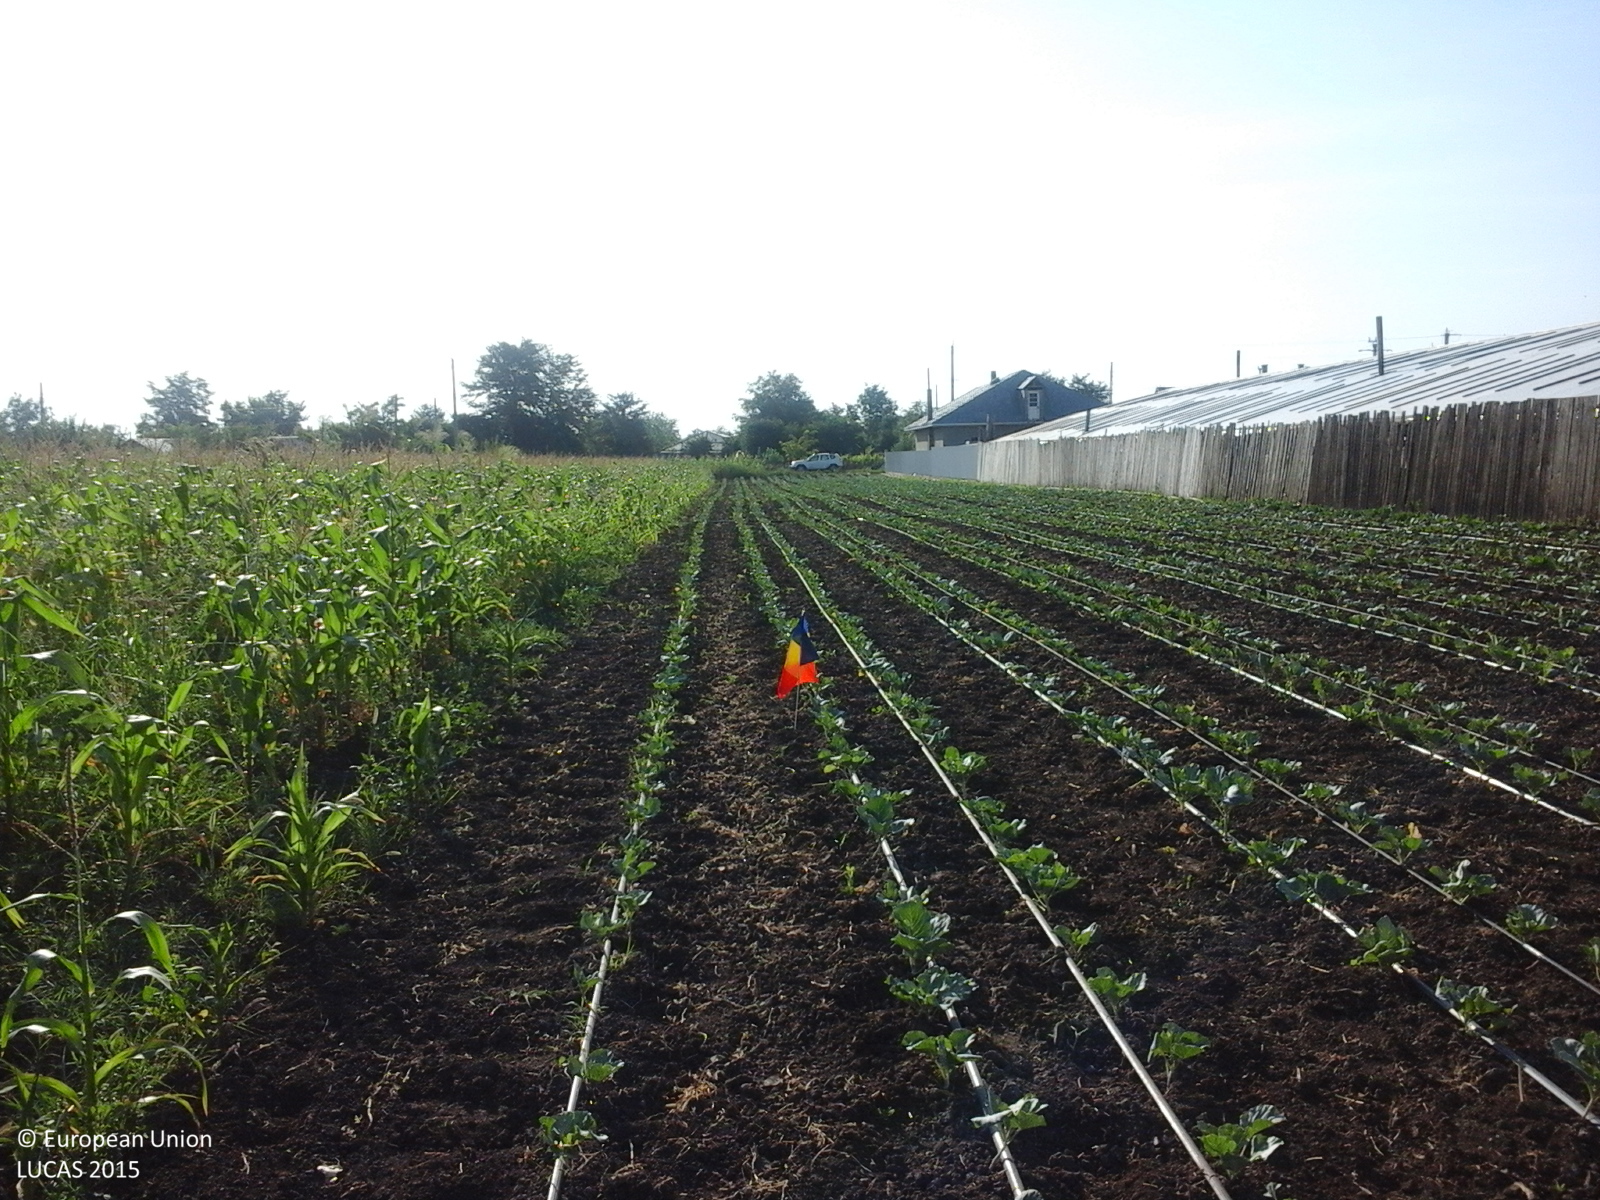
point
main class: Cropland
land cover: Other fresh vegetables
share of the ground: 10 - 25 %
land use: Agriculture (excluding fallow land and kitchen gardens)
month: July
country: RO
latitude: 45.9200
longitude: 27.4201
